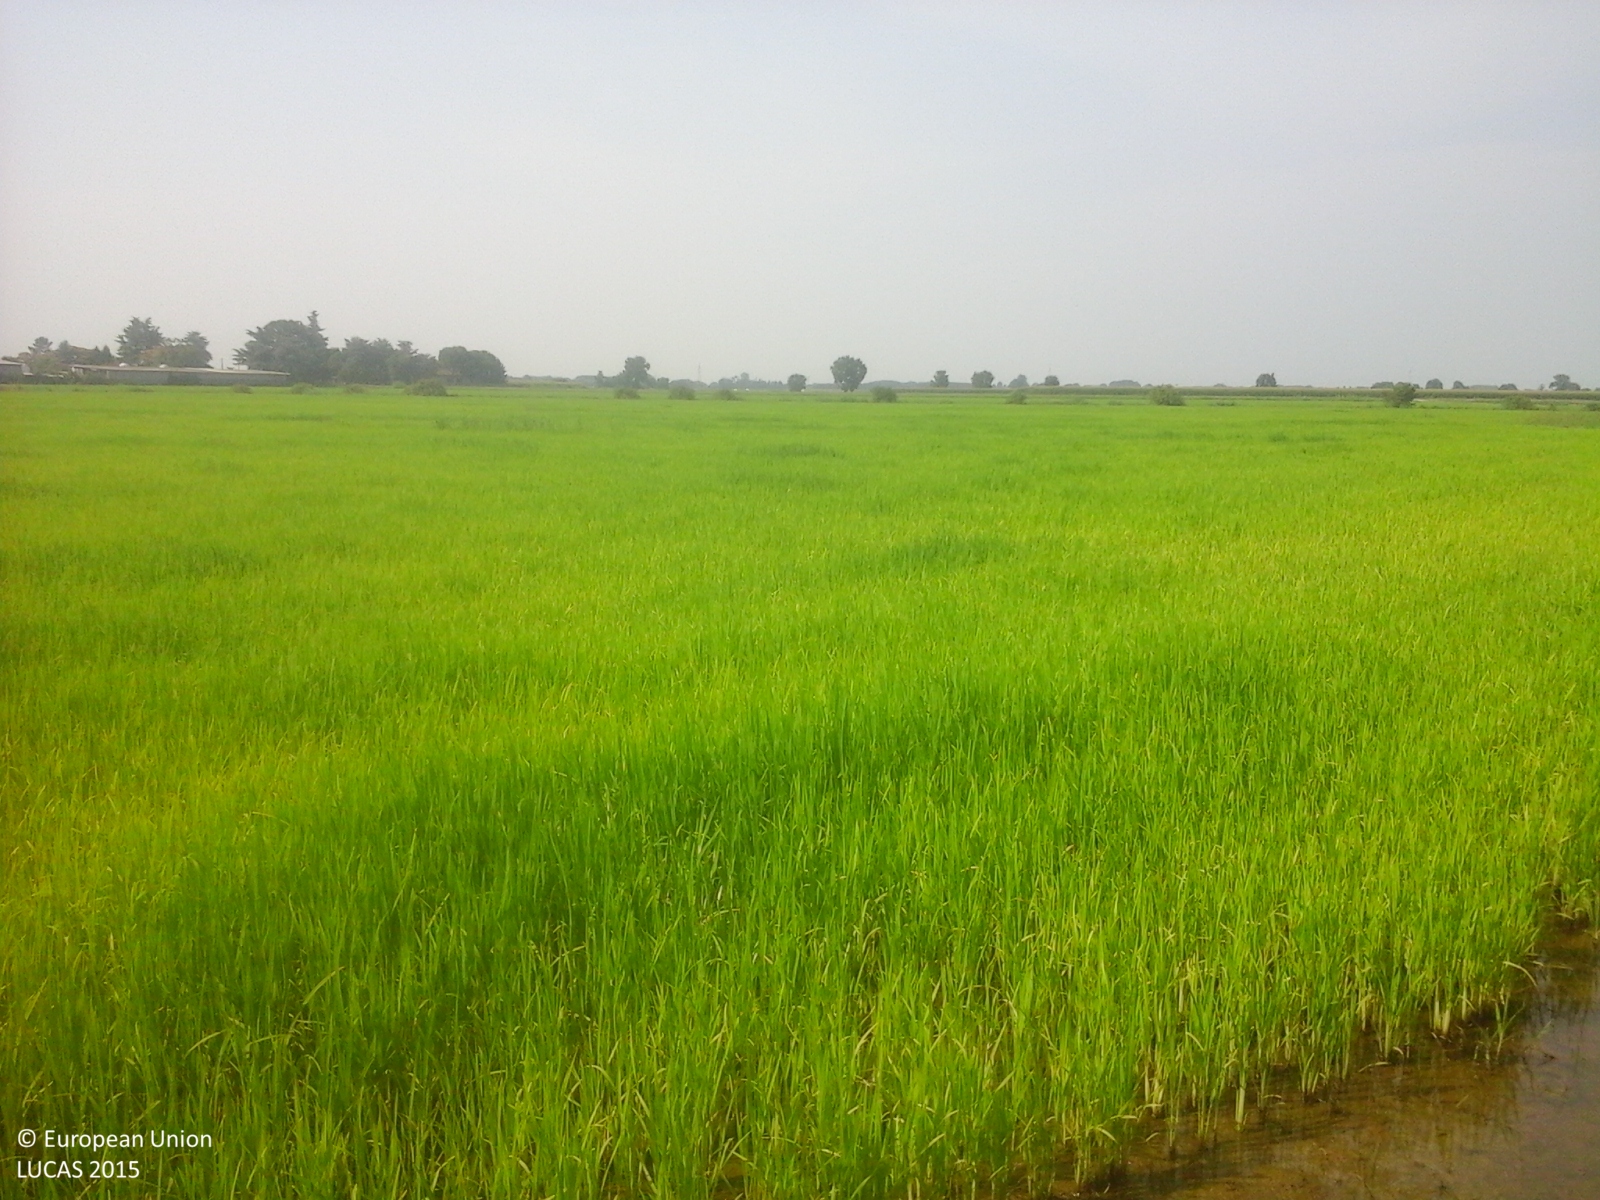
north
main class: Cropland
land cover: Rice
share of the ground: > 75 %
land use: Agriculture (excluding fallow land and kitchen gardens)
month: July
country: IT
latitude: 45.1776
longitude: 9.3014
